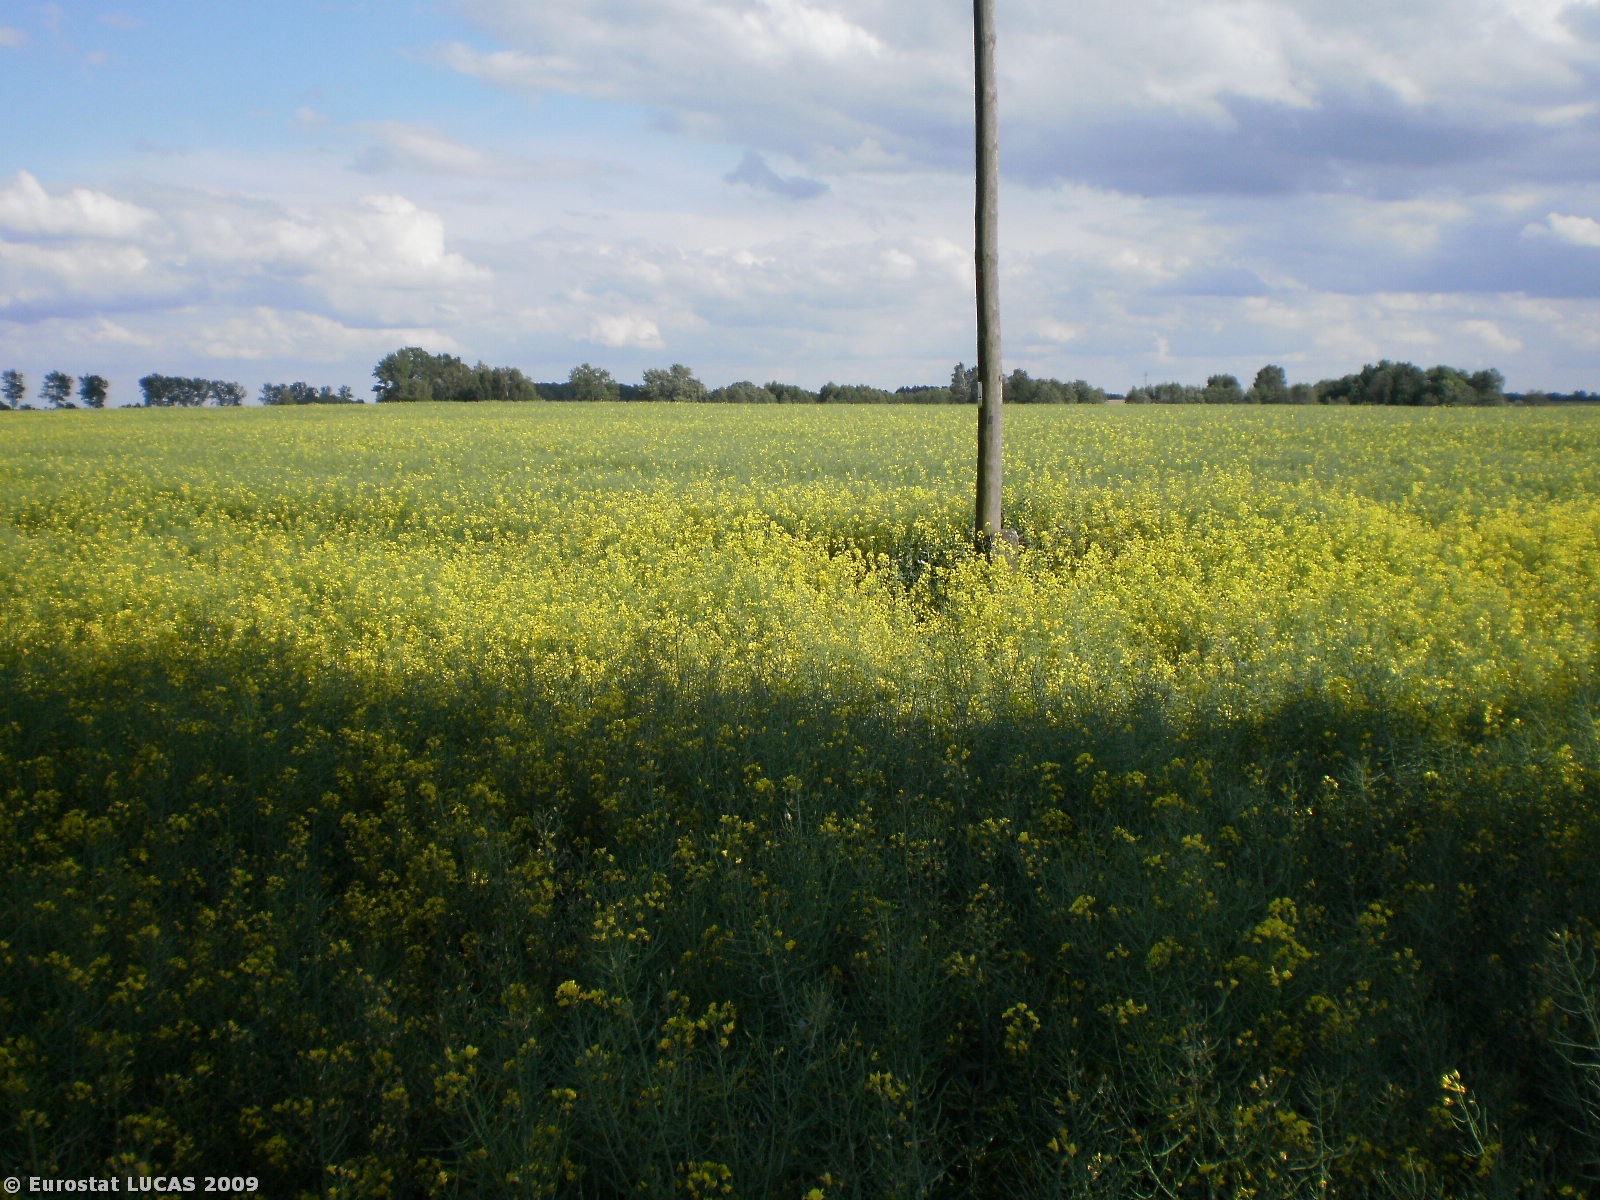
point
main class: Cropland
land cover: Rape and turnip rape
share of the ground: > 75 %
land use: Agriculture (excluding fallow land and kitchen gardens)
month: May
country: PL
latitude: 53.4649
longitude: 17.6799
